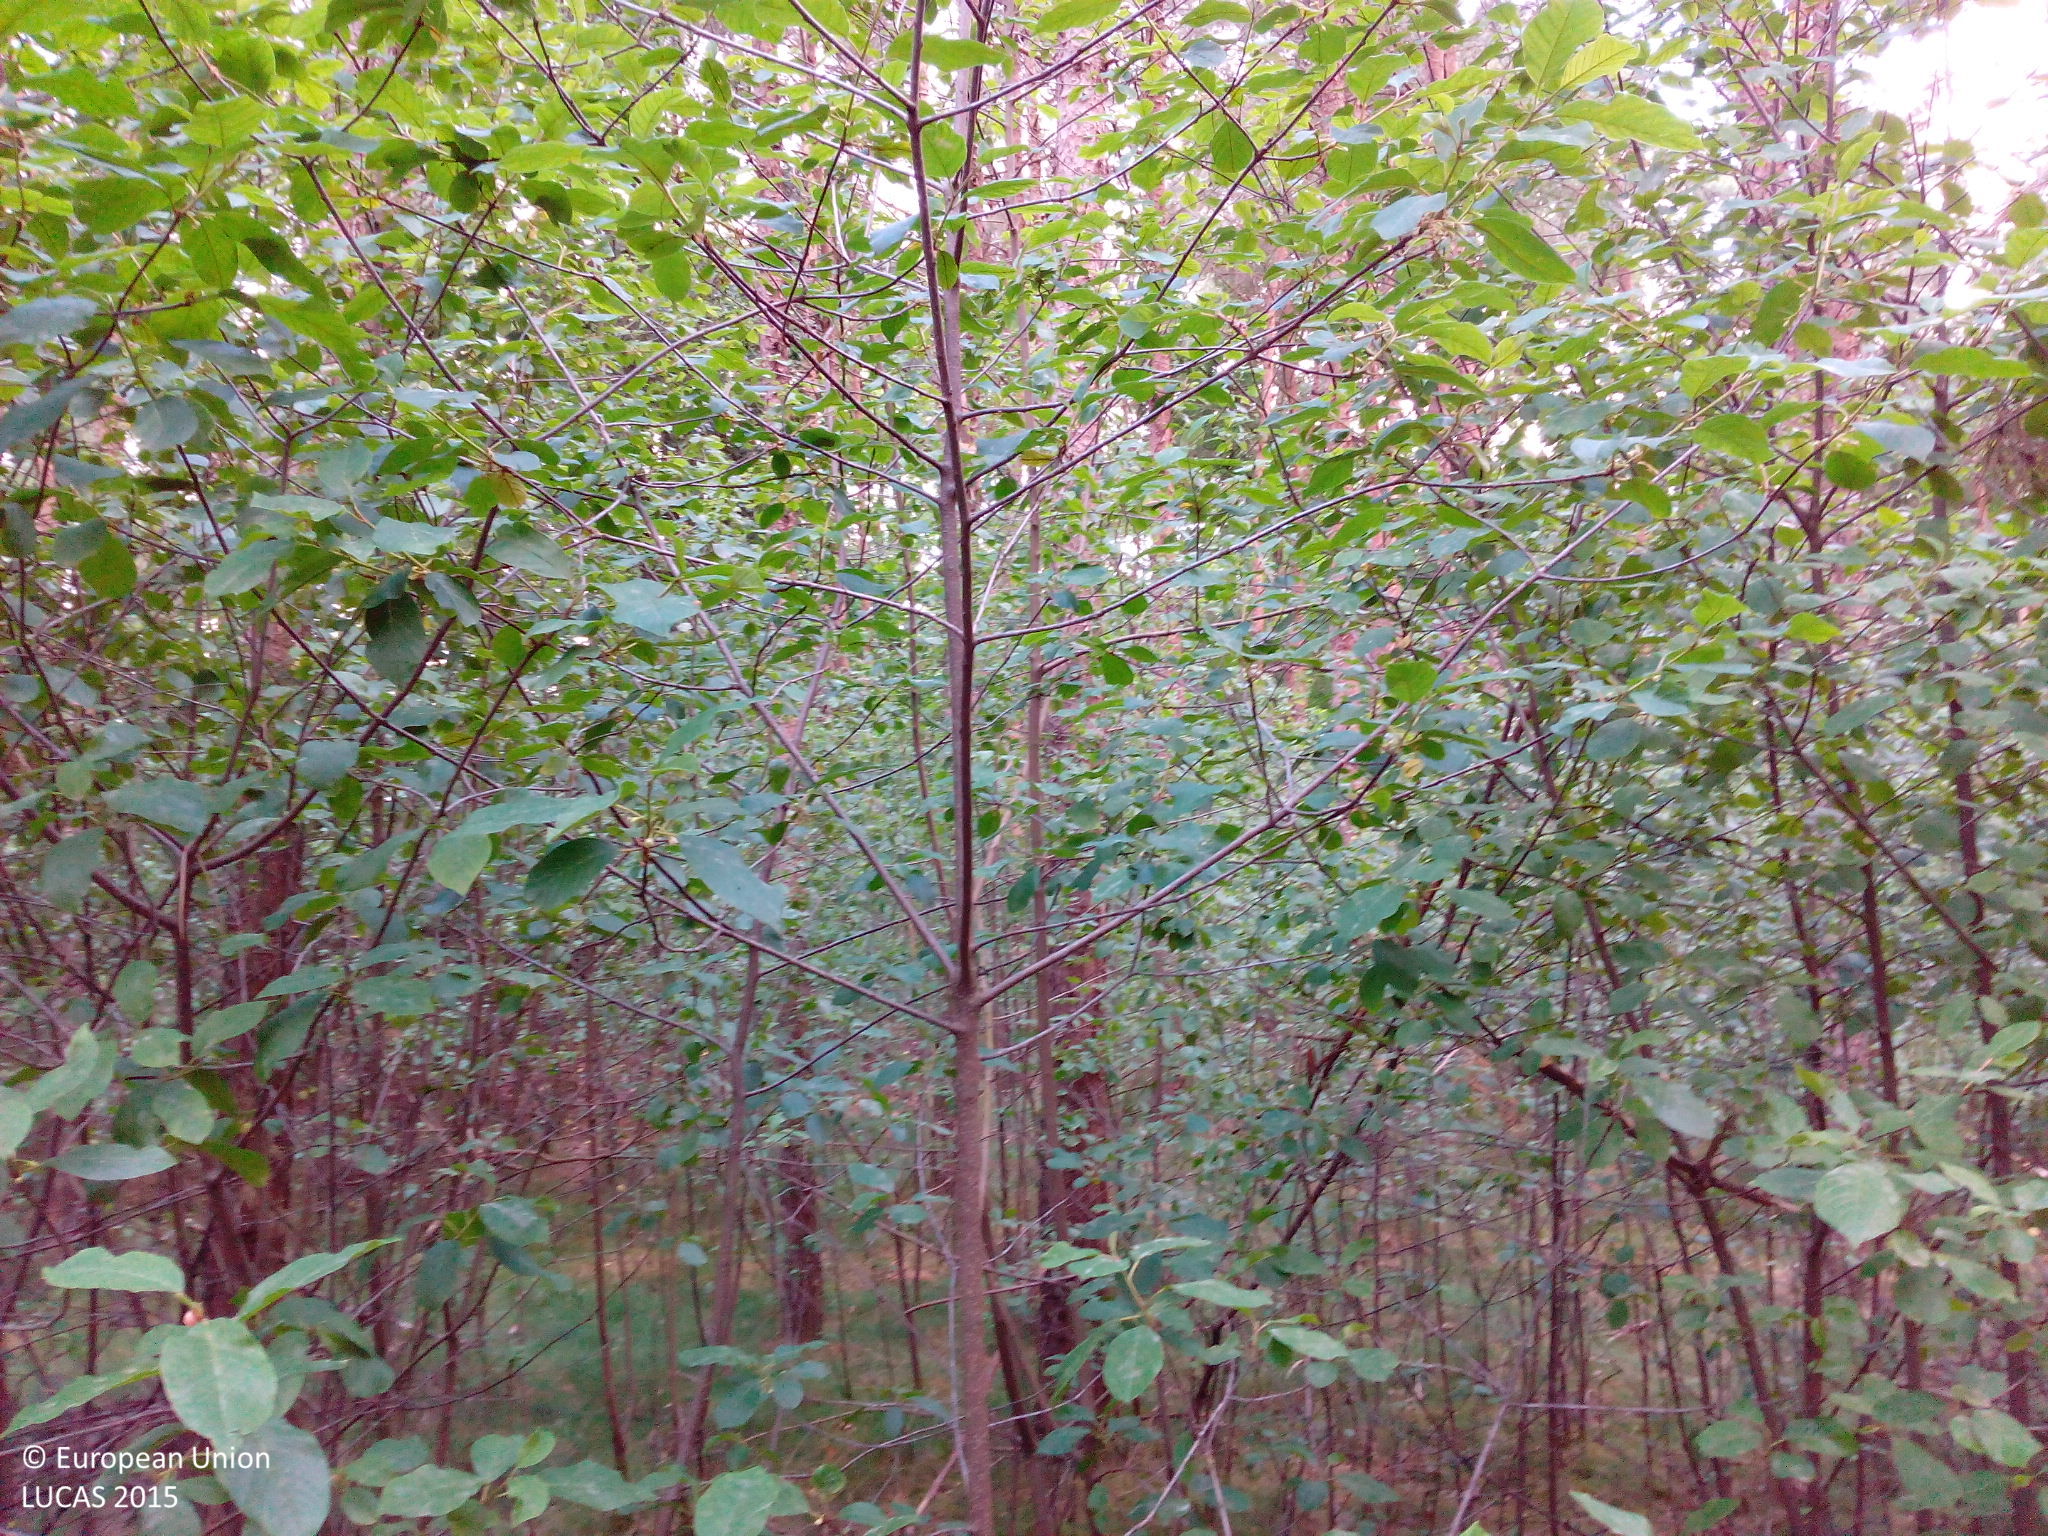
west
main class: Woodland
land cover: Pine dominated coniferous woodland
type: hemiboreal forest and nemoral coniferous forest and mixed broadleaved-coniferous forest
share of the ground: 50 - 75 %
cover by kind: coniferous forest trees 70 %, shrubs 15 %, herbaceous plants 10 %, broadleaved forest trees 5 %
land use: Forestry
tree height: > 5 m
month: June
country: DE
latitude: 52.6371
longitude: 7.4145
